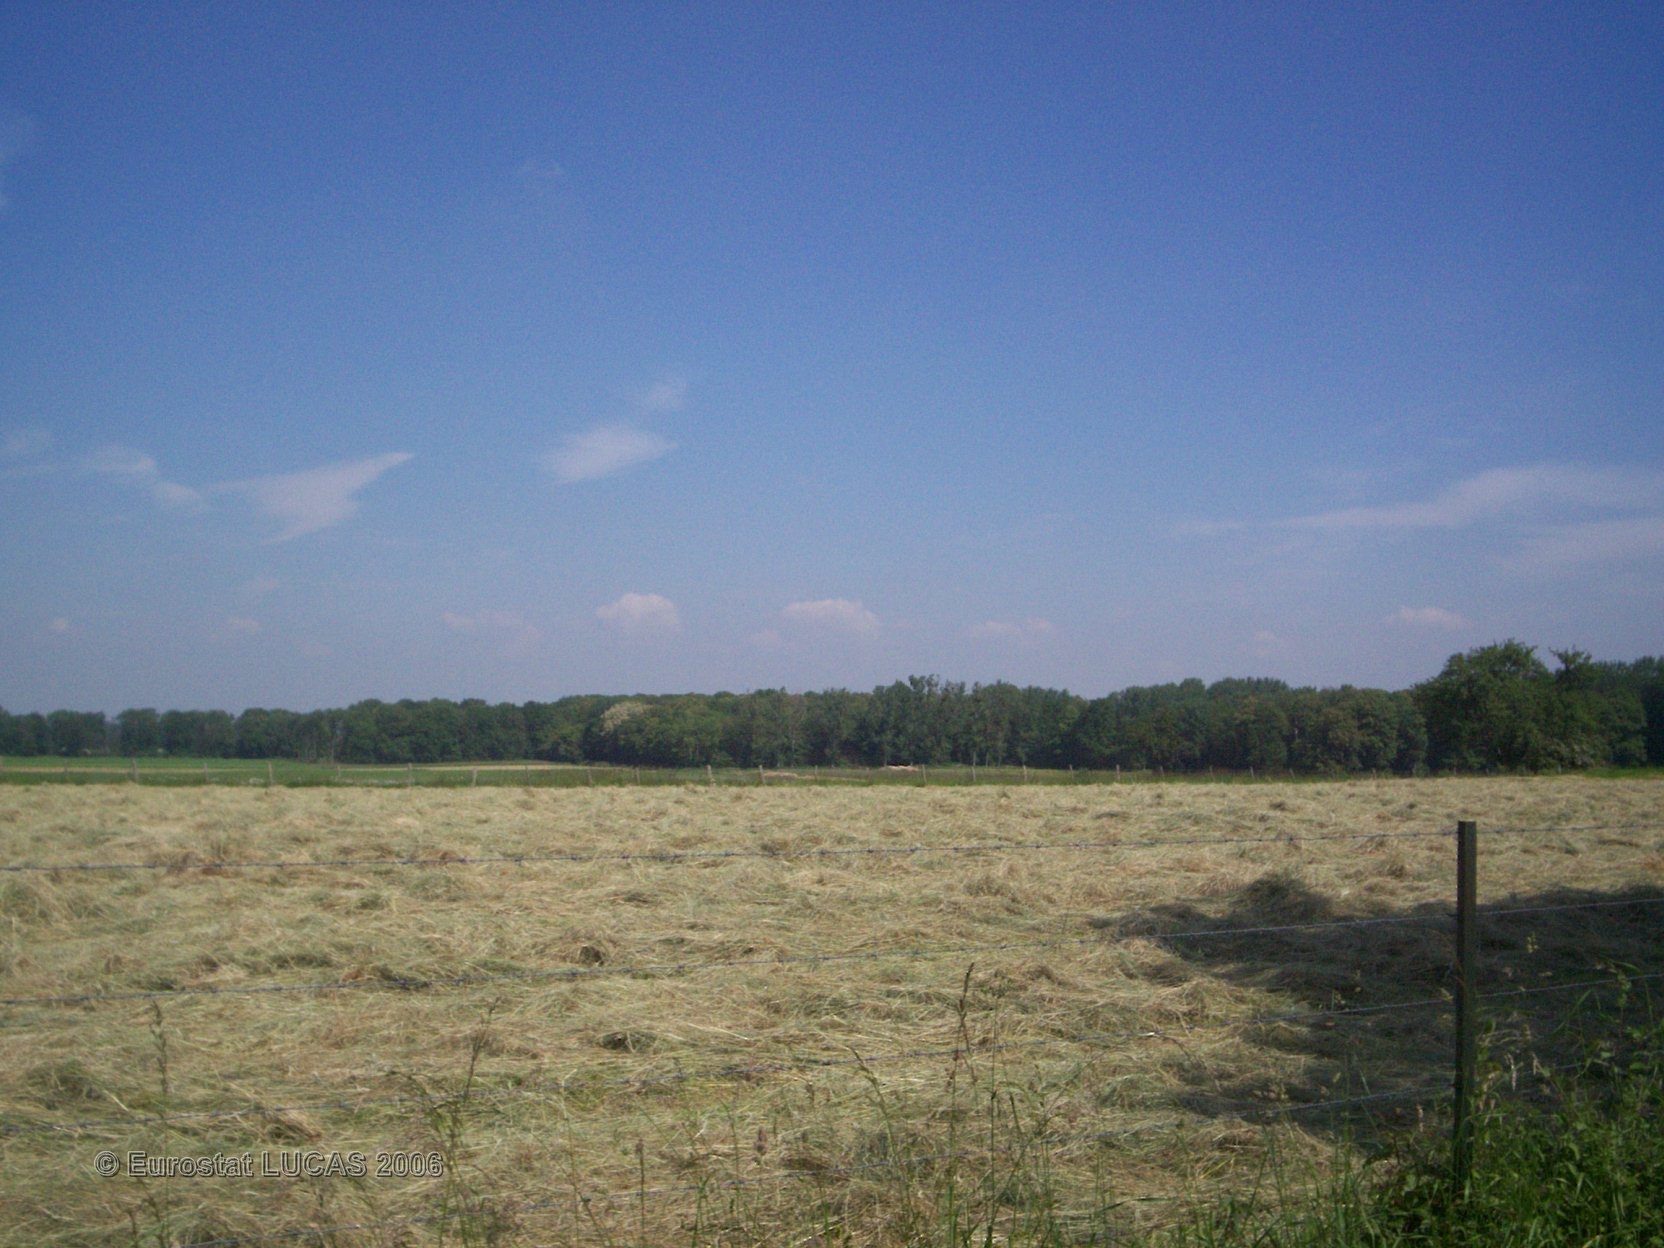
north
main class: Grassland
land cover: Grassland without tree/shrub cover
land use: Agriculture (excluding fallow land and kitchen gardens)
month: June
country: FR
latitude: 49.6247
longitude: 2.6935
